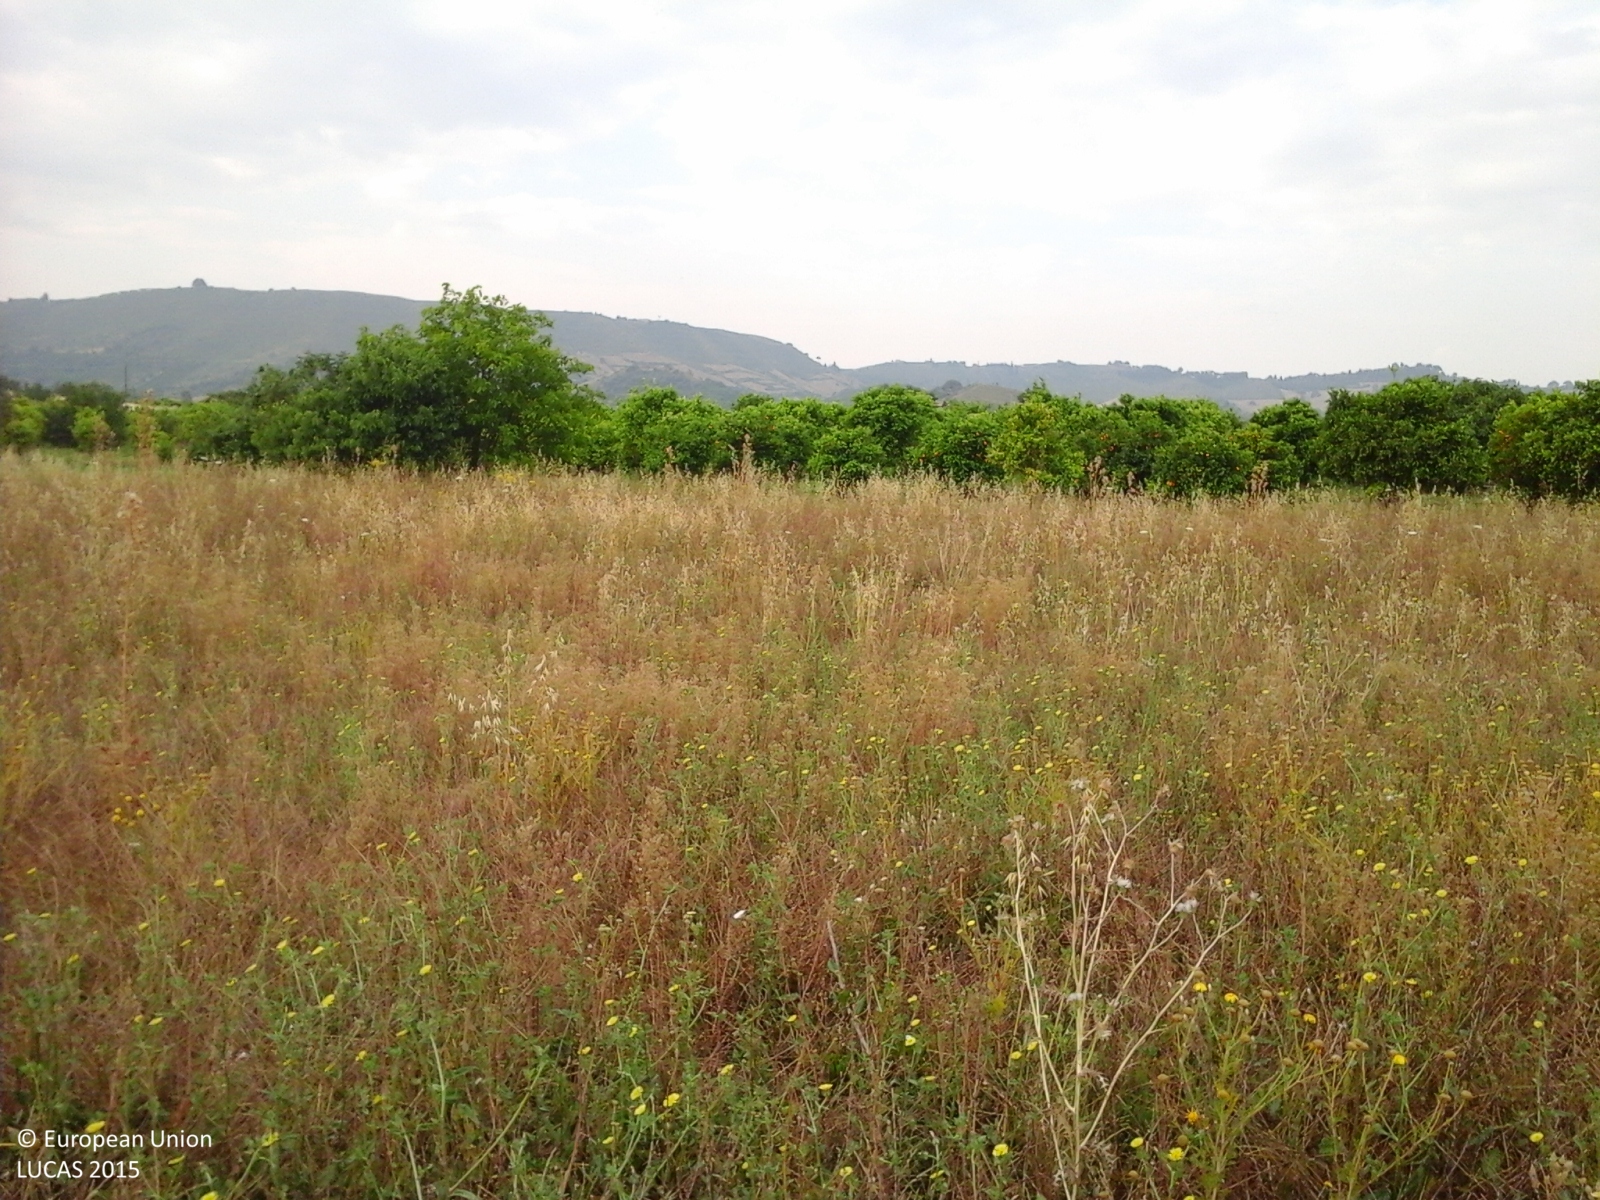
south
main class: Grassland
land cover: Spontaneously vegetated surfaces
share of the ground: > 75 %
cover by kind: herbaceous plants 100 %
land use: Fallow land
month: June
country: IT
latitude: 37.2374
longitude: 14.5754
